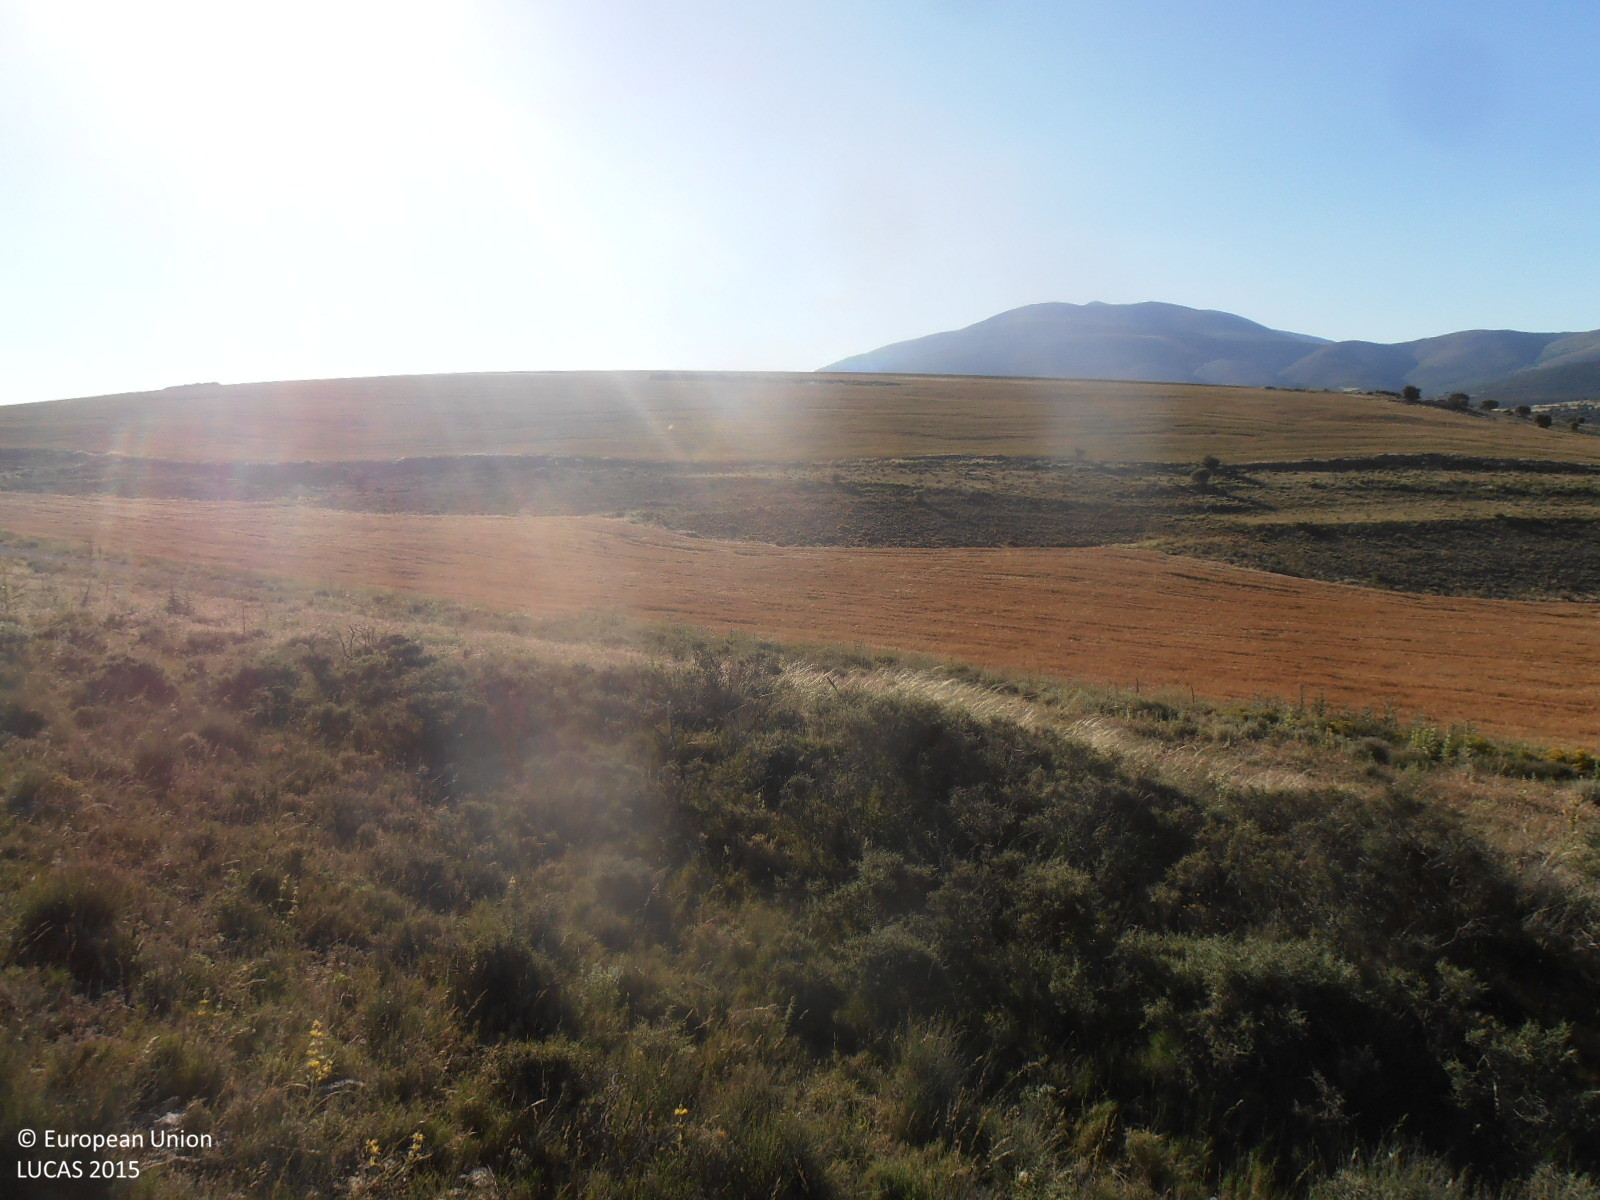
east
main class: Shrubland
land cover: Shrubland without tree cover
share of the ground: > 75 %
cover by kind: shrubs 80 %, herbaceous plants 10 %, consolidated bare surface 10 %
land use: Semi-natural and natural areas not in use
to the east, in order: Shrubland without tree cover; Grassland without tree/shrub cover; Shruby margins; Tracks; Shruby margins; Barley; Shrubland without tree cover; Common wheat
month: June
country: ES
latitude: 41.8325
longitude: -1.9661
